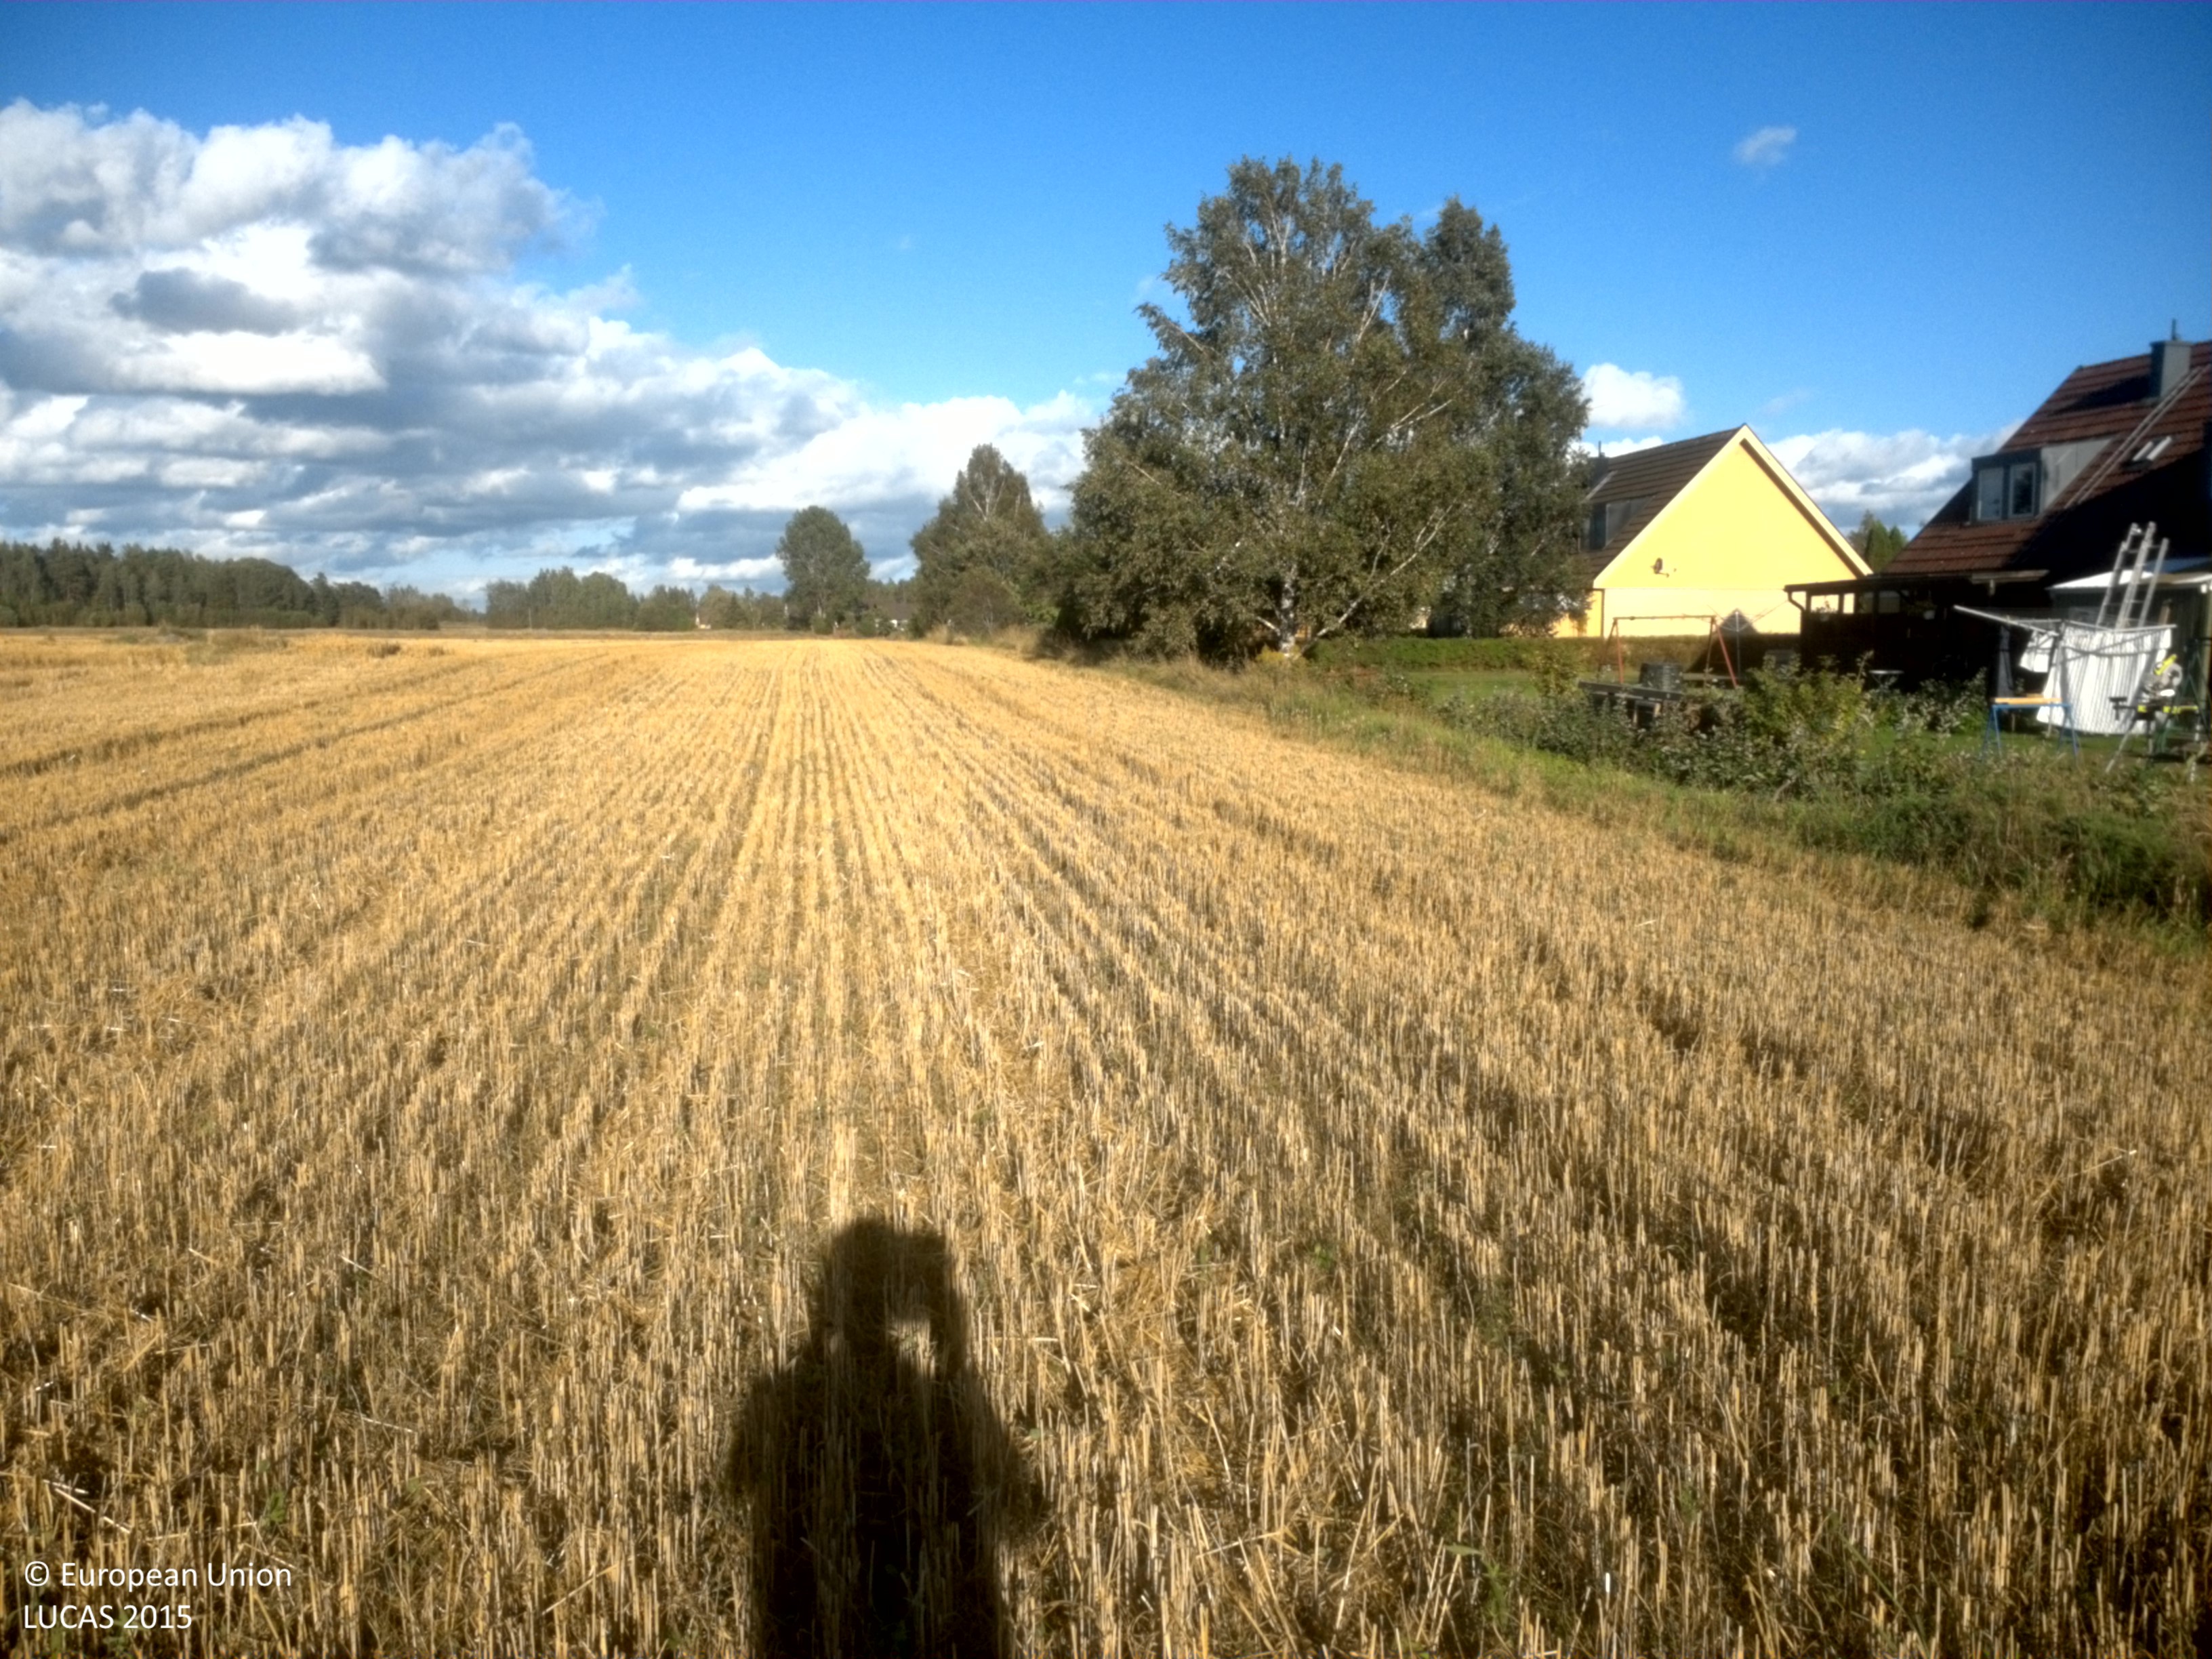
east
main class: Cropland
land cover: Common wheat
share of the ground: > 75 %
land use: Agriculture (excluding fallow land and kitchen gardens)
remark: Harvested field
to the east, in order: Common wheat; Grass margins; Artificial constructions in urban areas; Grassland without tree/shrub cover; Paved roads, cycling and walking lanes
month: August
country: SE
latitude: 59.4386
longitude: 15.5808
